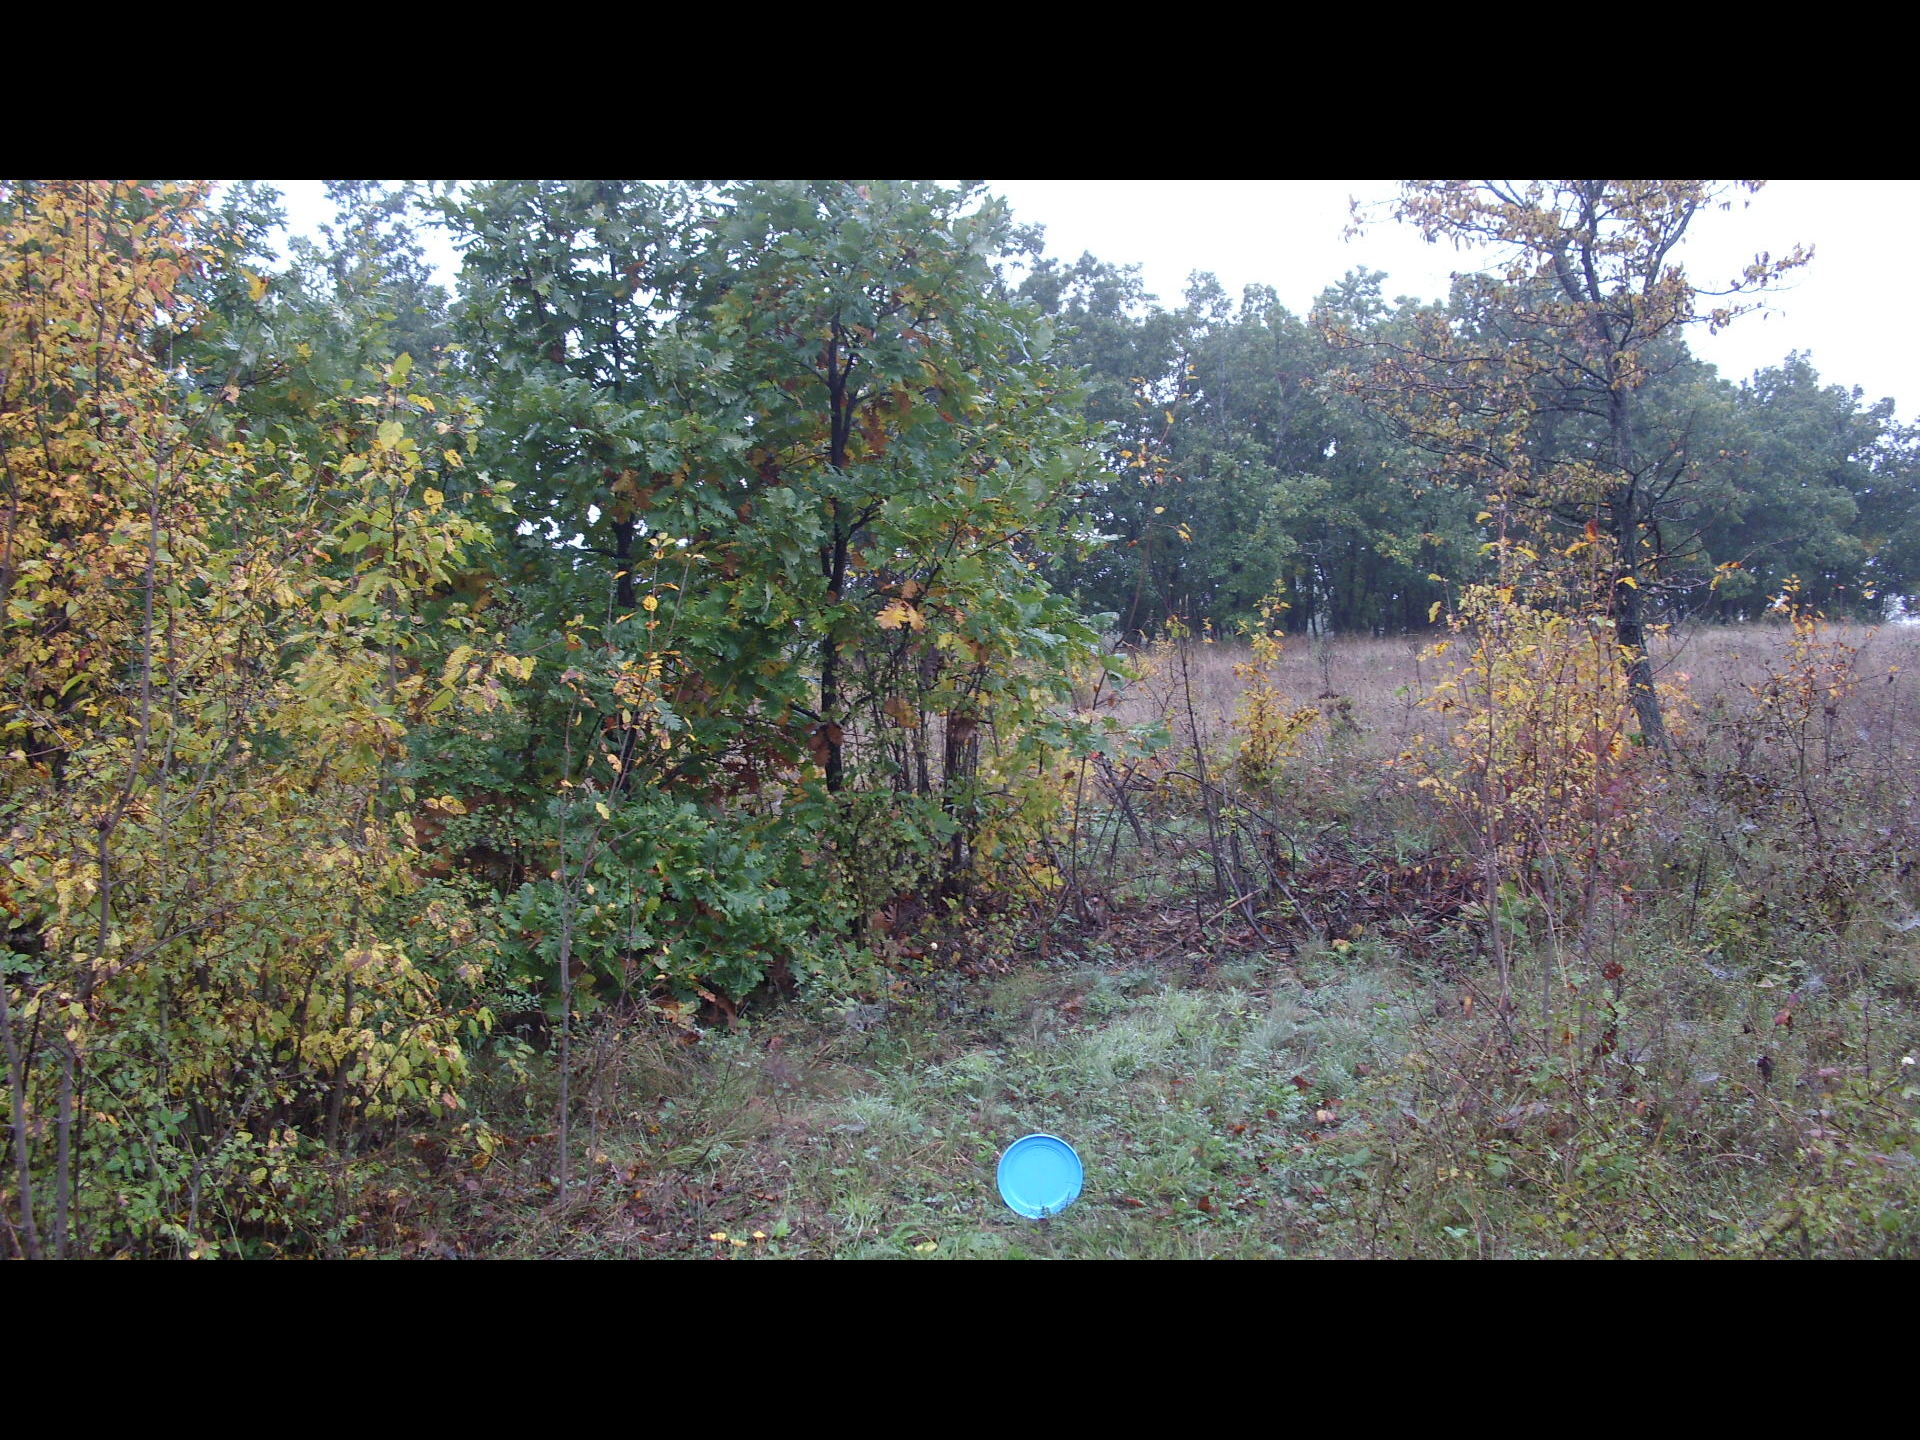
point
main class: Grassland
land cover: Grassland with sparse tree/shrub cover
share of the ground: > 75 %
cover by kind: herbaceous plants 90 %, broadleaved forest trees 5 %, shrubs 5 %
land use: Semi-natural and natural areas not in use
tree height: < 5 m
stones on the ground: < 10 %
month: October
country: BG
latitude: 43.6915
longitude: 22.5762
